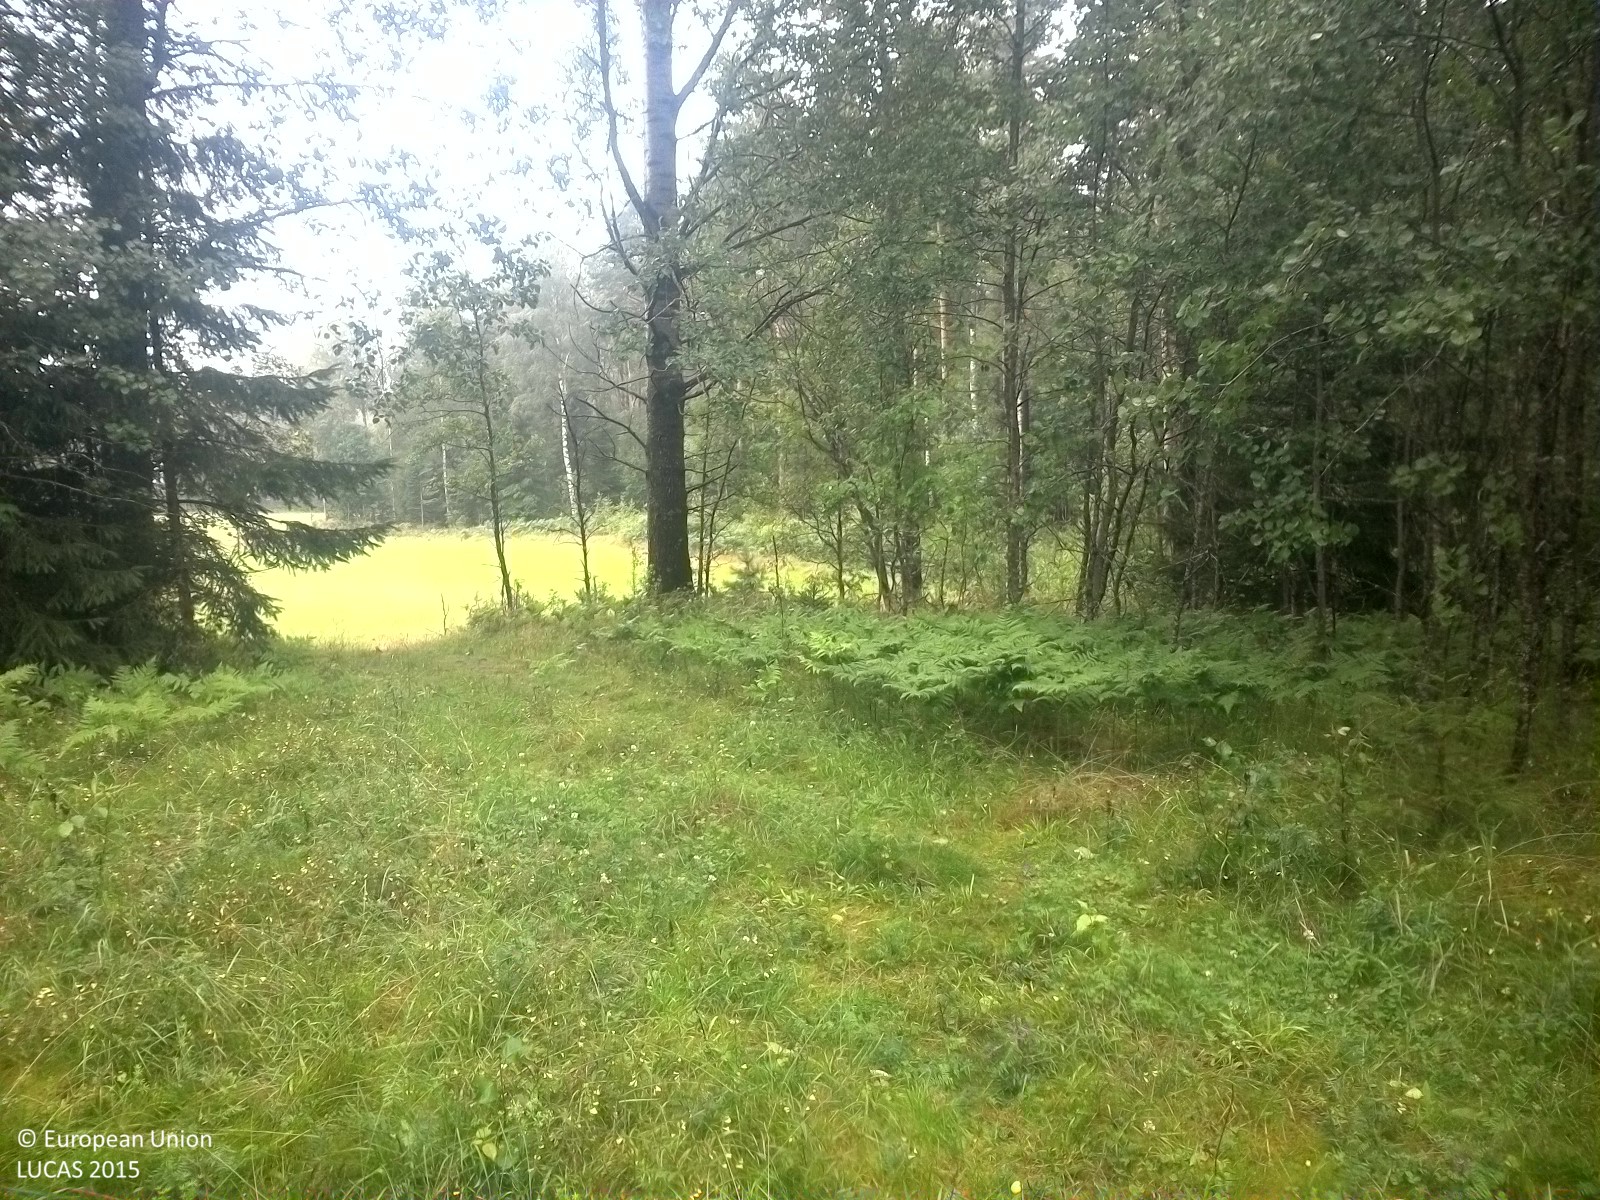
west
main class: Grassland
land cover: Grassland without tree/shrub cover
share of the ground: > 75 %
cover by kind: herbaceous plants 100 %
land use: Semi-natural and natural areas not in use
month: July
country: SE
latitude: 58.9360
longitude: 15.0487
